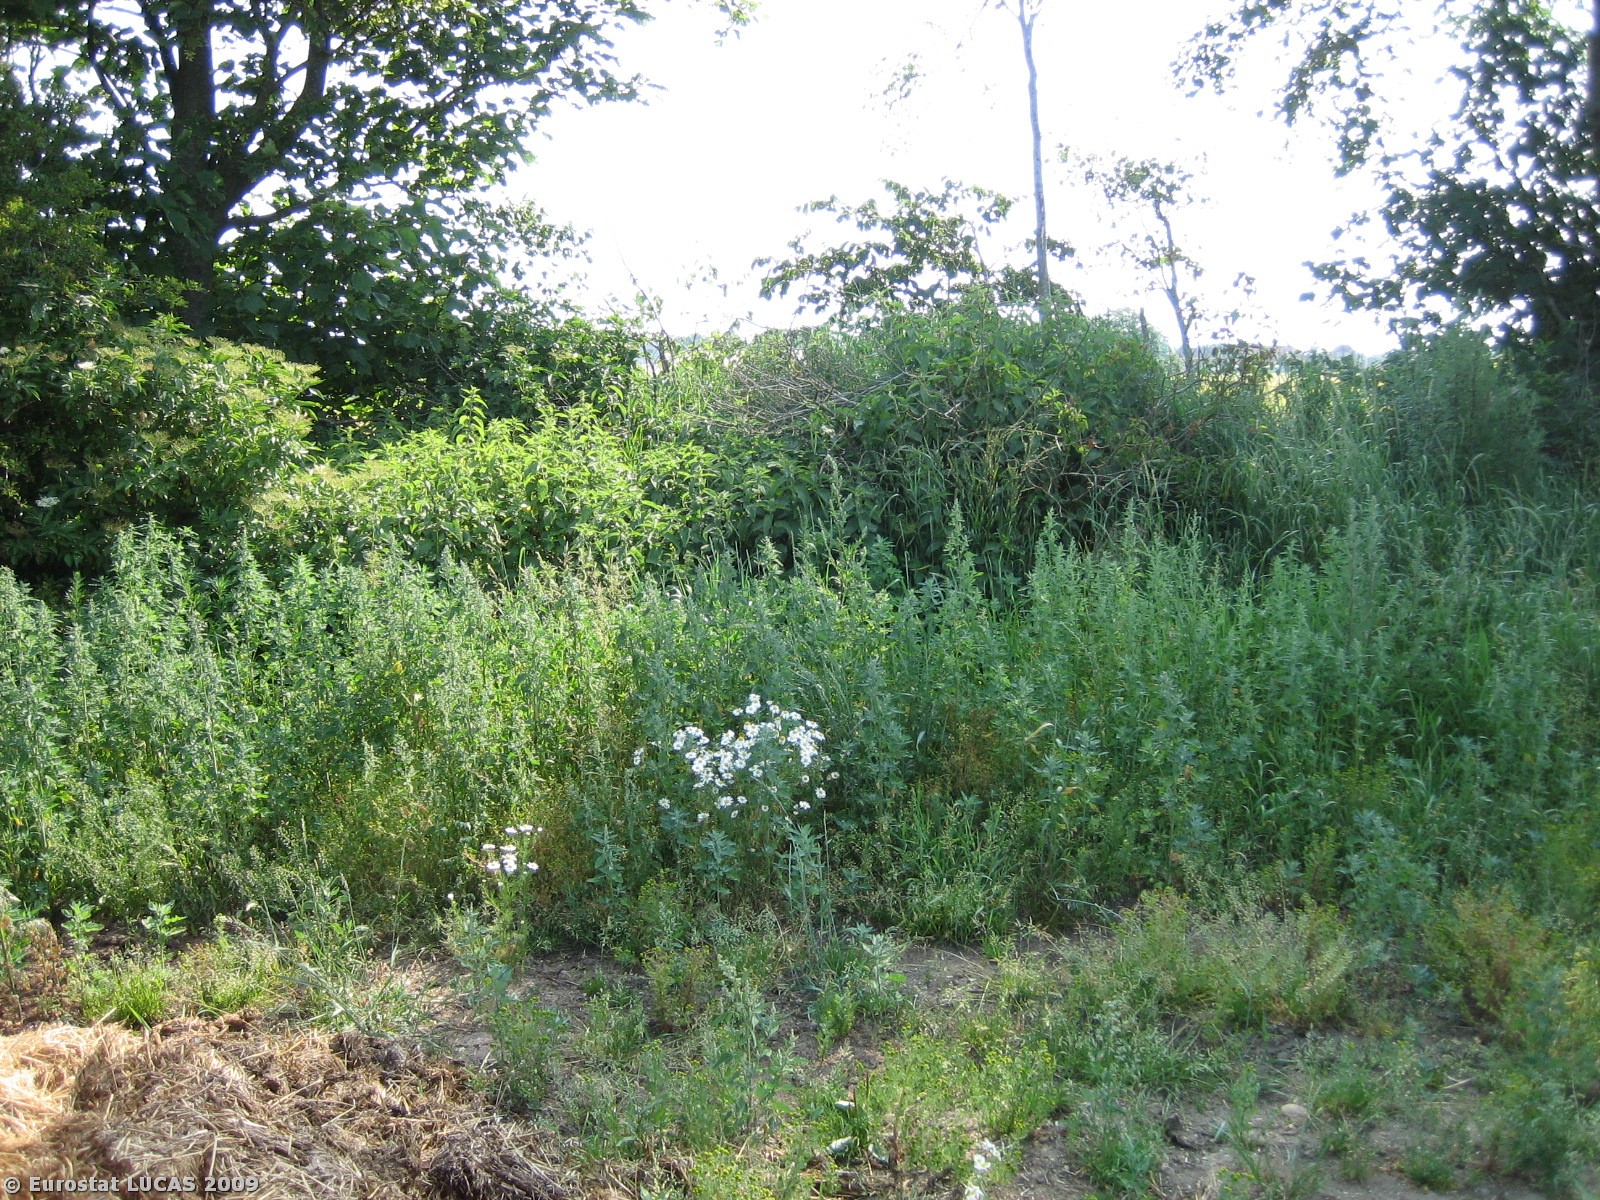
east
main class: Grassland
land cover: Grassland without tree/shrub cover
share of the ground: > 75 %
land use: Agriculture (excluding fallow land and kitchen gardens)
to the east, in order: Grassland without tree/shrub cover; Fences; Broadleaved woodland; Barley; Fences; Grass margins; Temporary grasslands
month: July
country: DK
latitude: 55.5187
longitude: 9.0031
